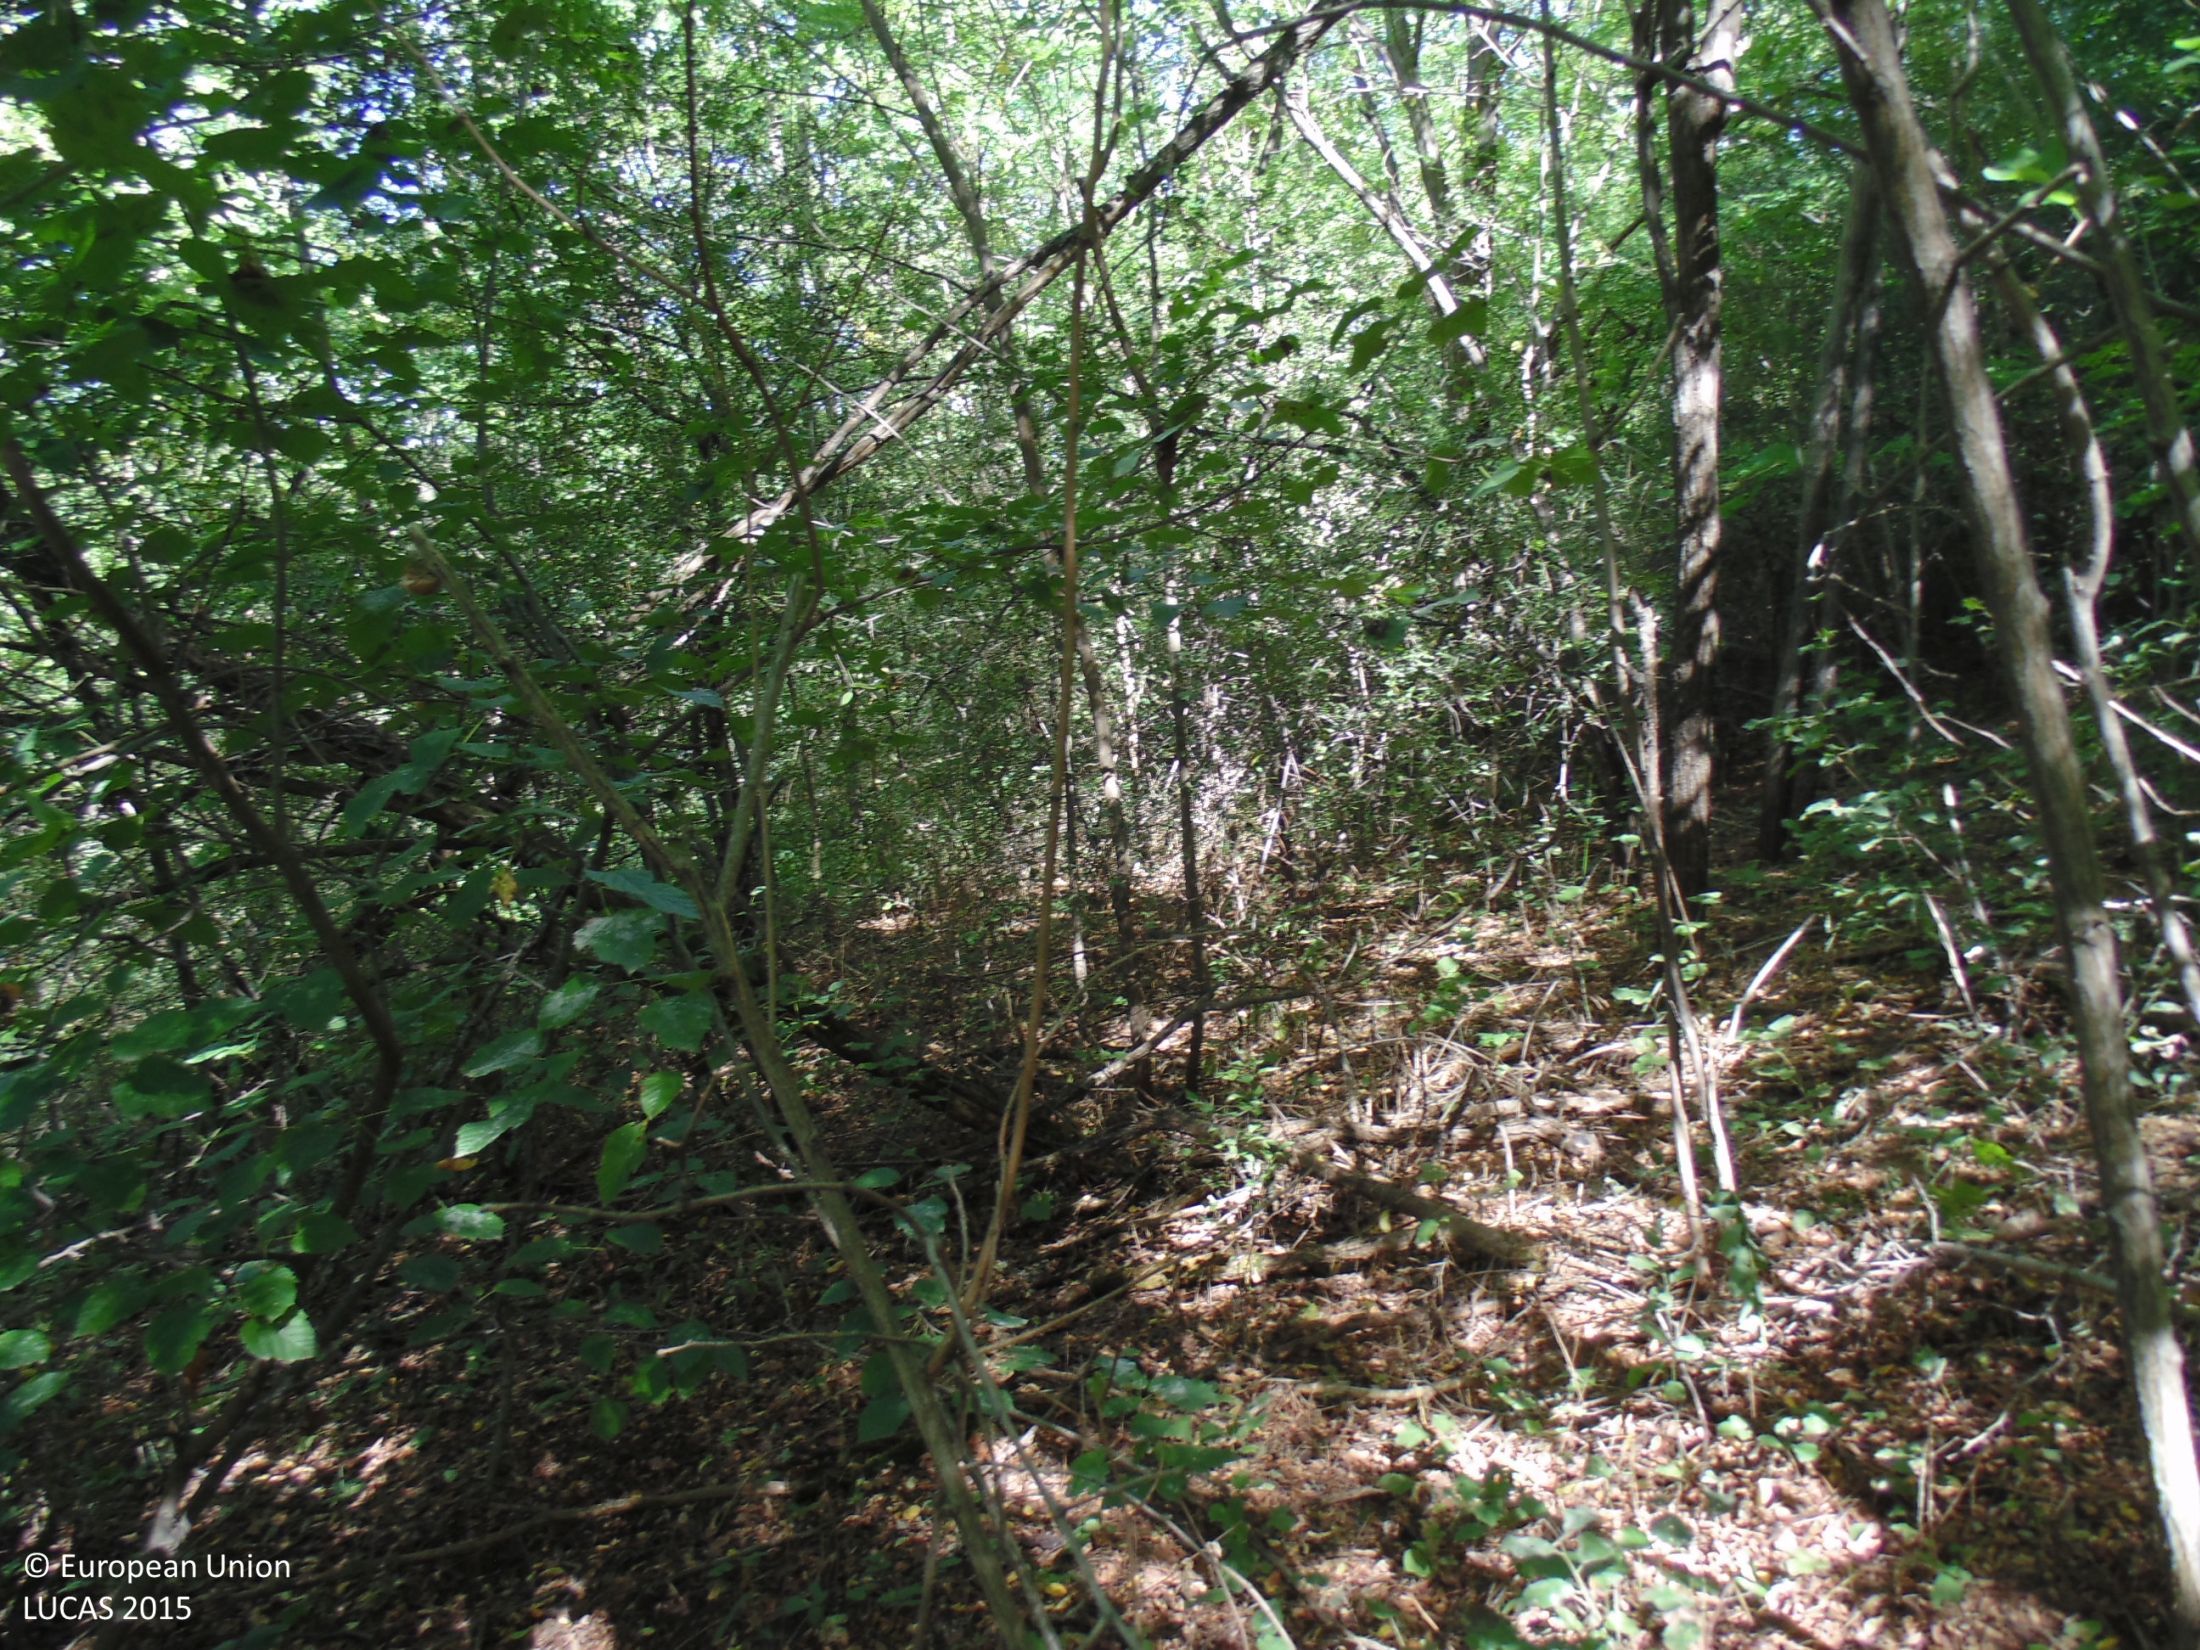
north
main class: Woodland
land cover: Broadleaved woodland
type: mesophytic deciduous forest
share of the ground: > 75 %
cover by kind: broadleaved forest trees 90 %, shrubs 5 %, herbaceous plants 5 %
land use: Forestry
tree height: > 5 m
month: September
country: BG
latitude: 44.0771
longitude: 26.9940
